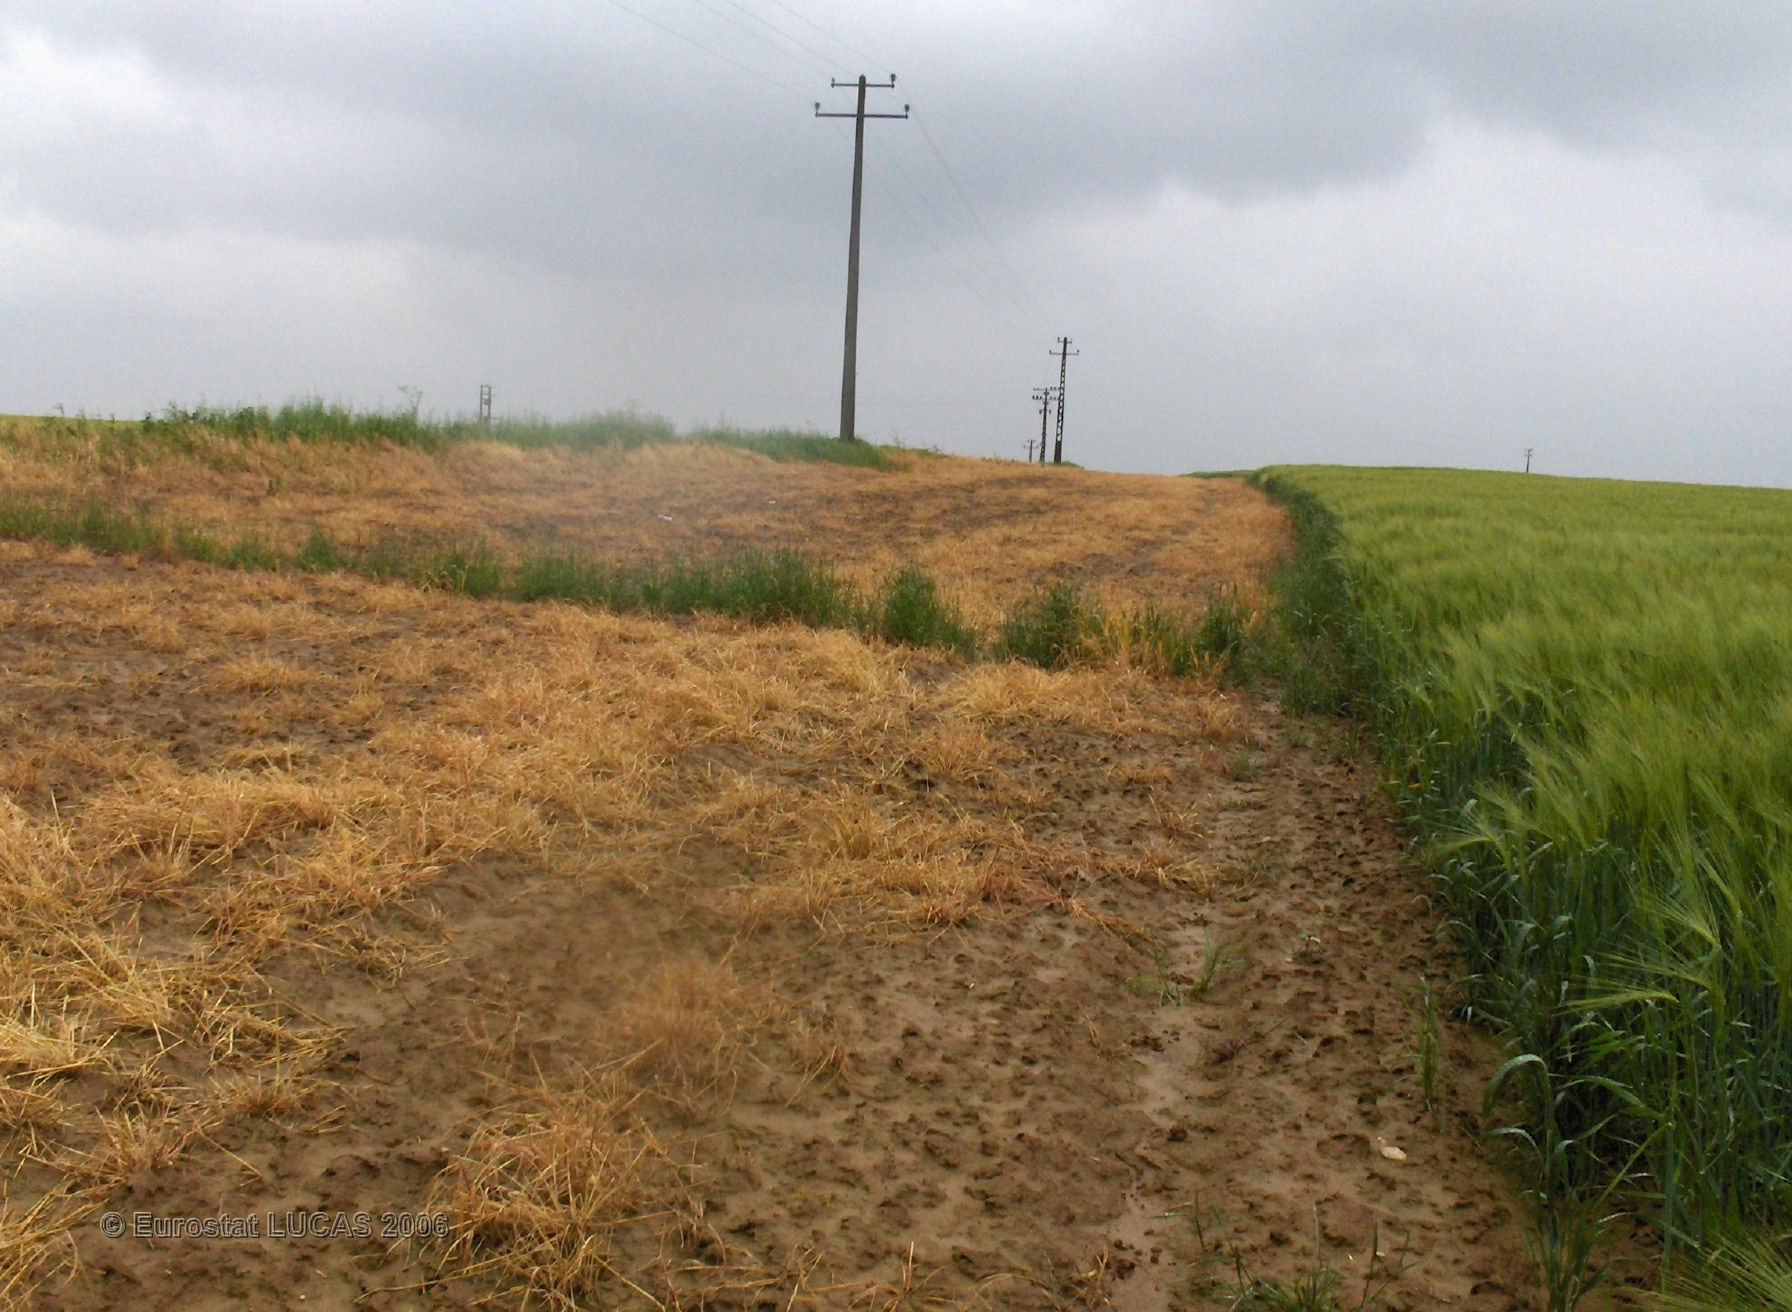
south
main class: Cropland
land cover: Barley
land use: Agriculture (excluding fallow land and kitchen gardens)
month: June
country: BE
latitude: 50.1934
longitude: 5.2492
